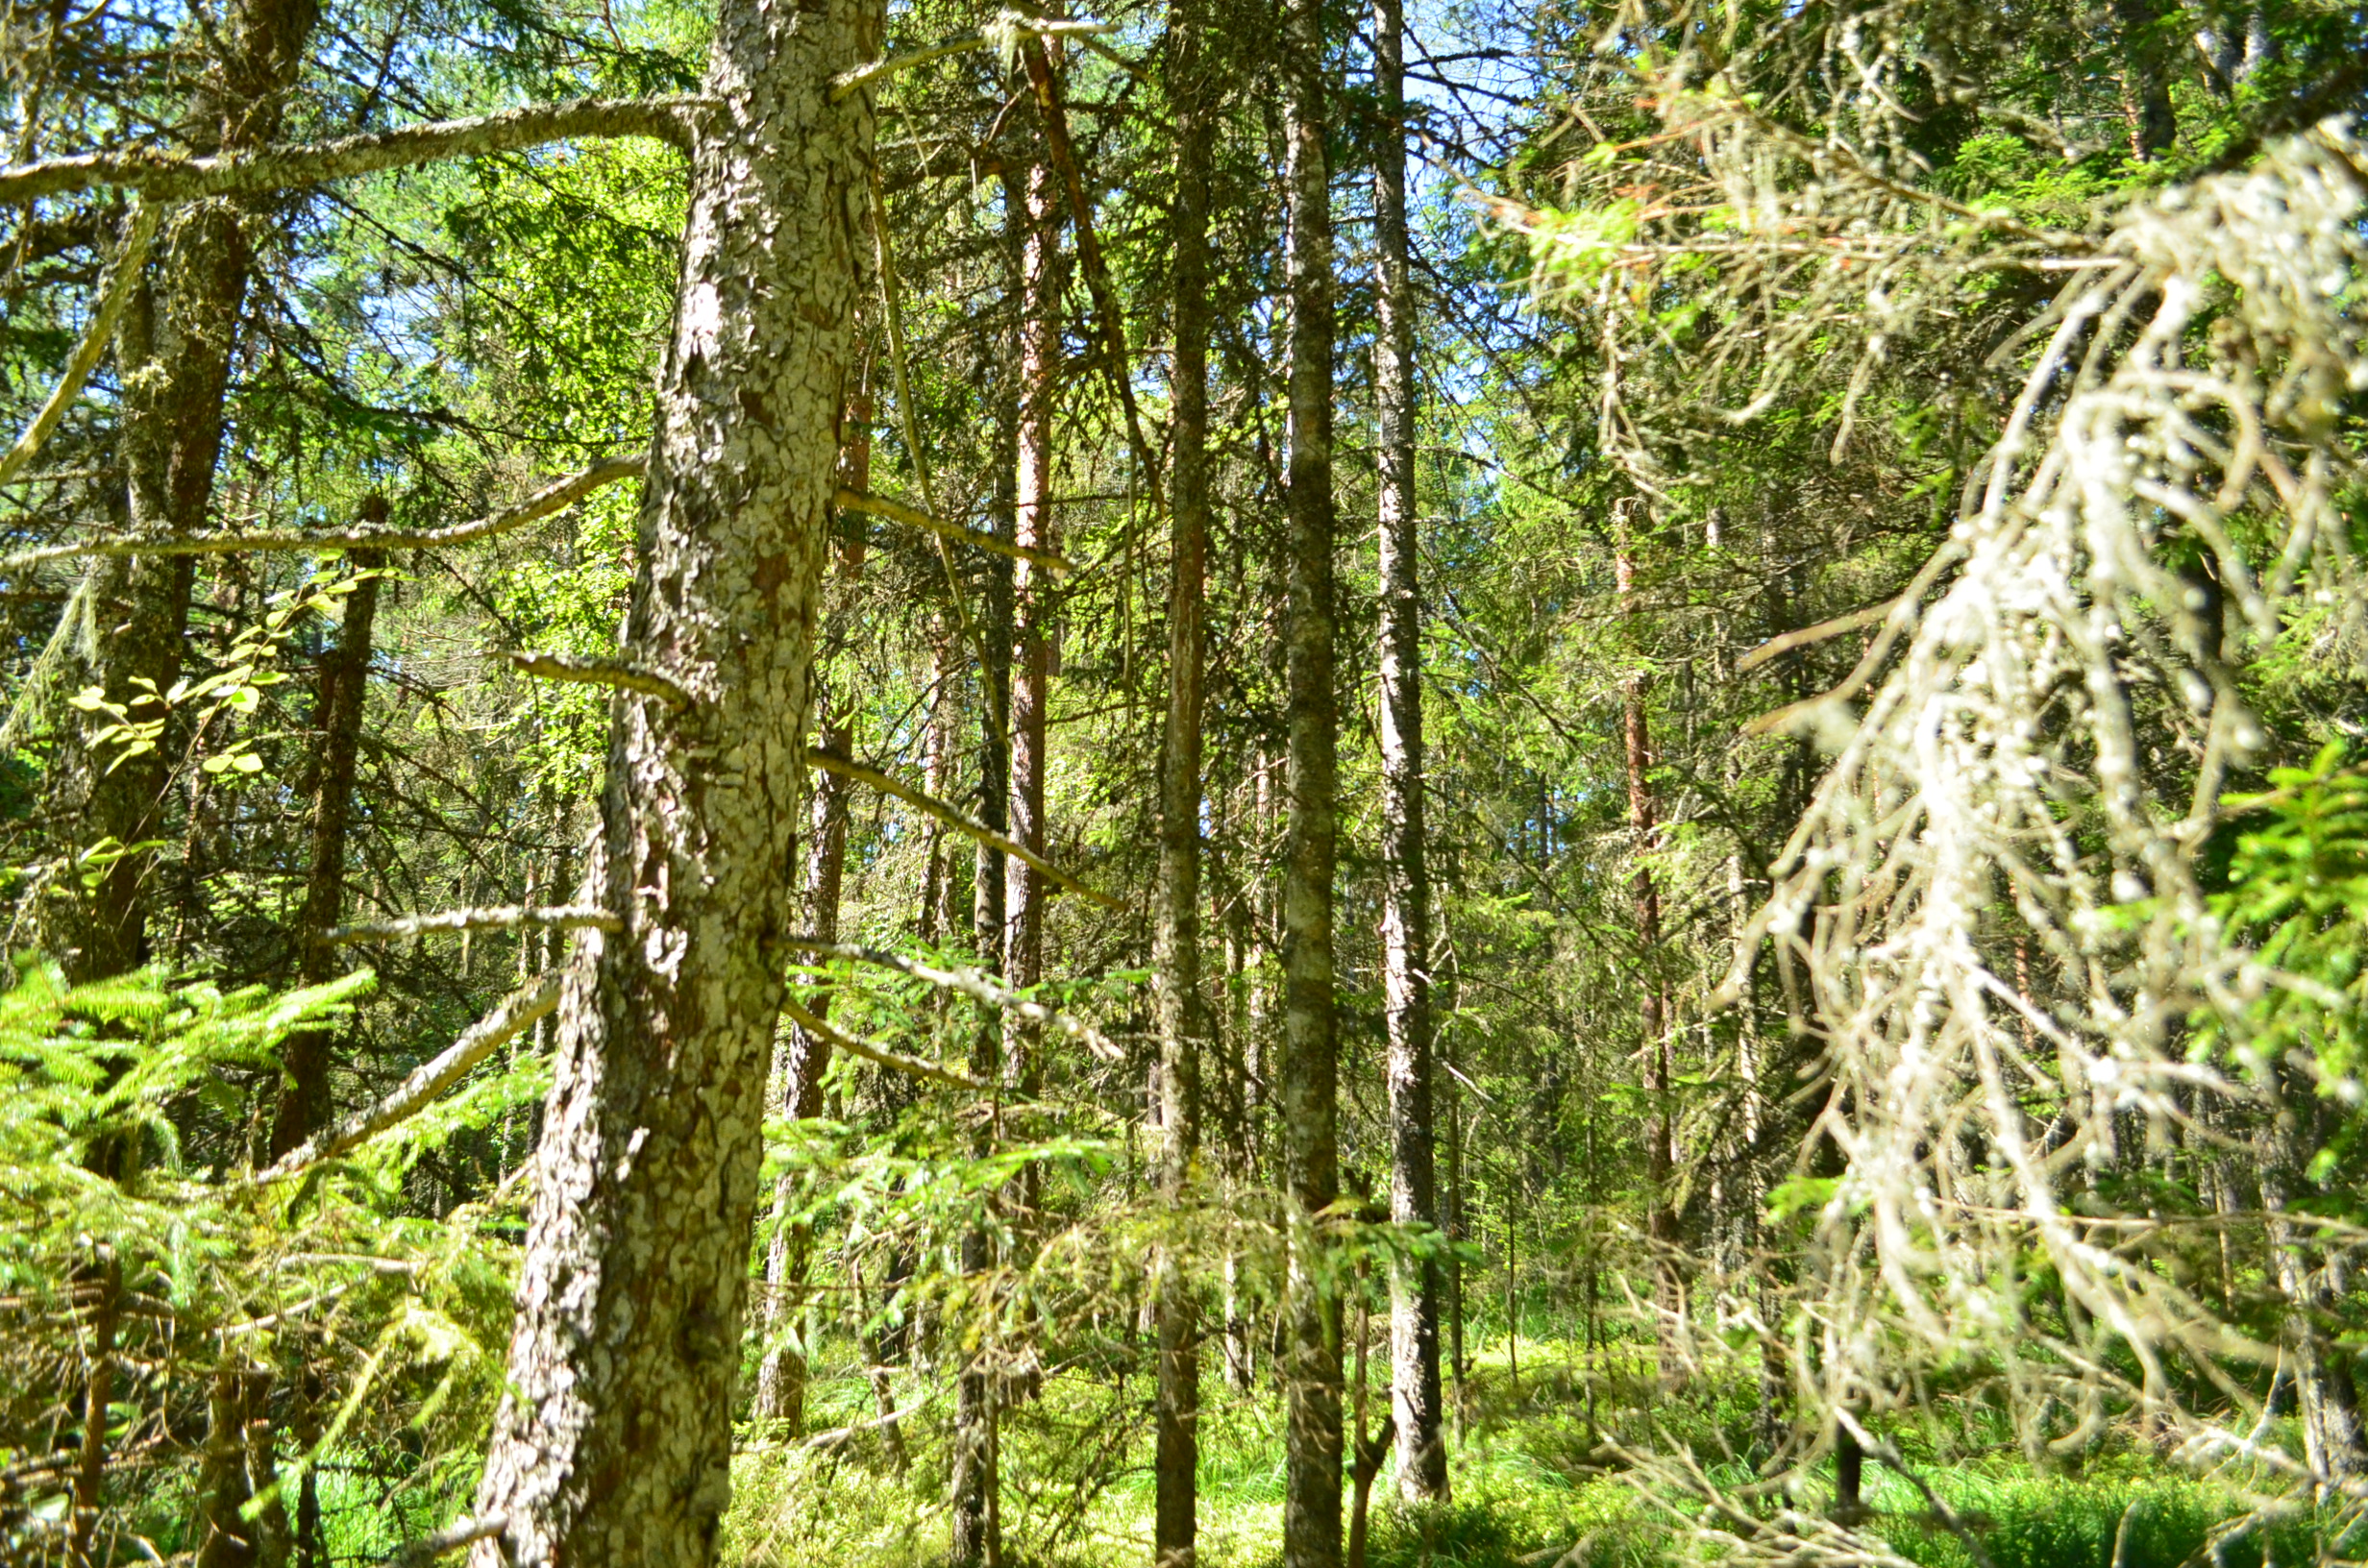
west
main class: Woodland
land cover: Other coniferous woodland
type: hemiboreal forest and nemoral coniferous forest and mixed broadleaved-coniferous forest
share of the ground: 50 - 75 %
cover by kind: coniferous forest trees 70 %, shrubs 10 %, herbaceous plants 10 %, broadleaved forest trees 5 %, lichens and mosses 5 %
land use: Forestry
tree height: > 5 m
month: August
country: LV
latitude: 57.5606
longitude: 22.3013
